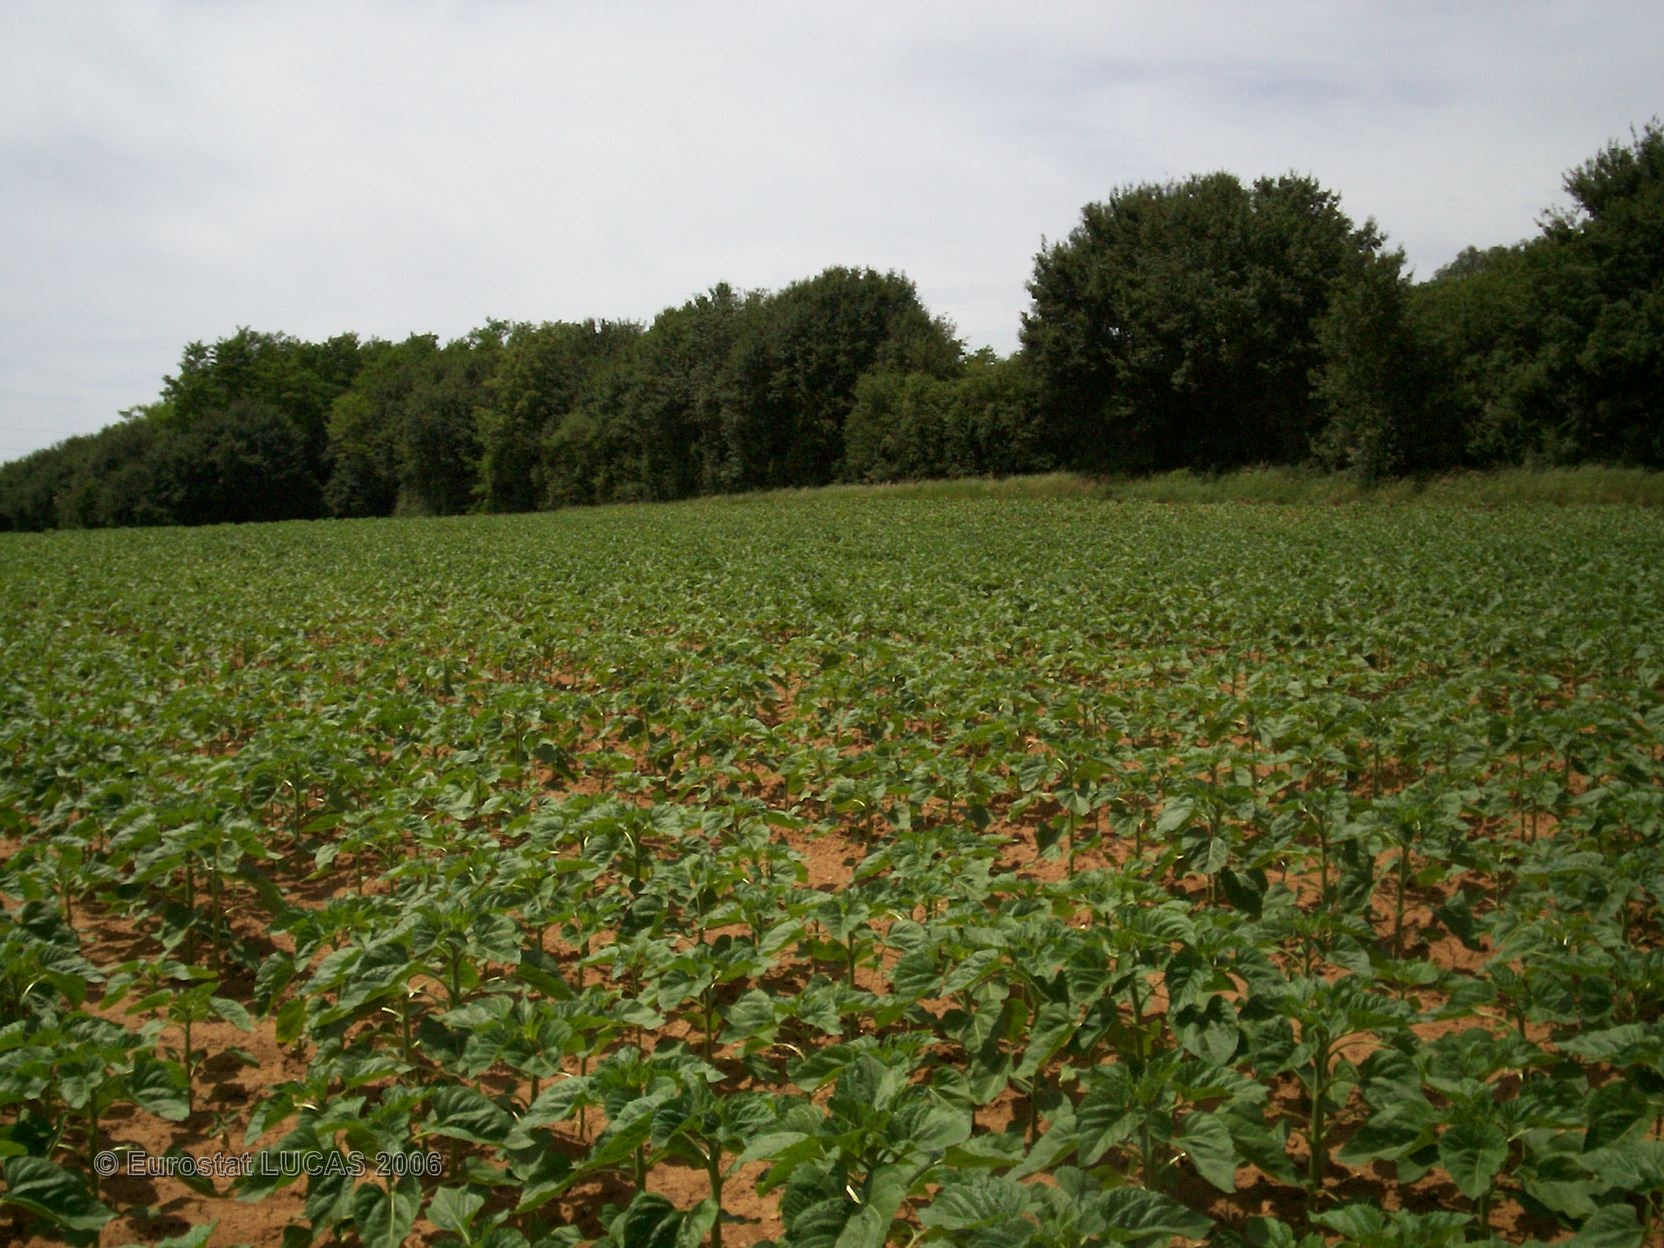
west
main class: Cropland
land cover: Sunflower
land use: Agriculture (excluding fallow land and kitchen gardens)
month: June
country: FR
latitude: 47.6671
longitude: 6.0725
